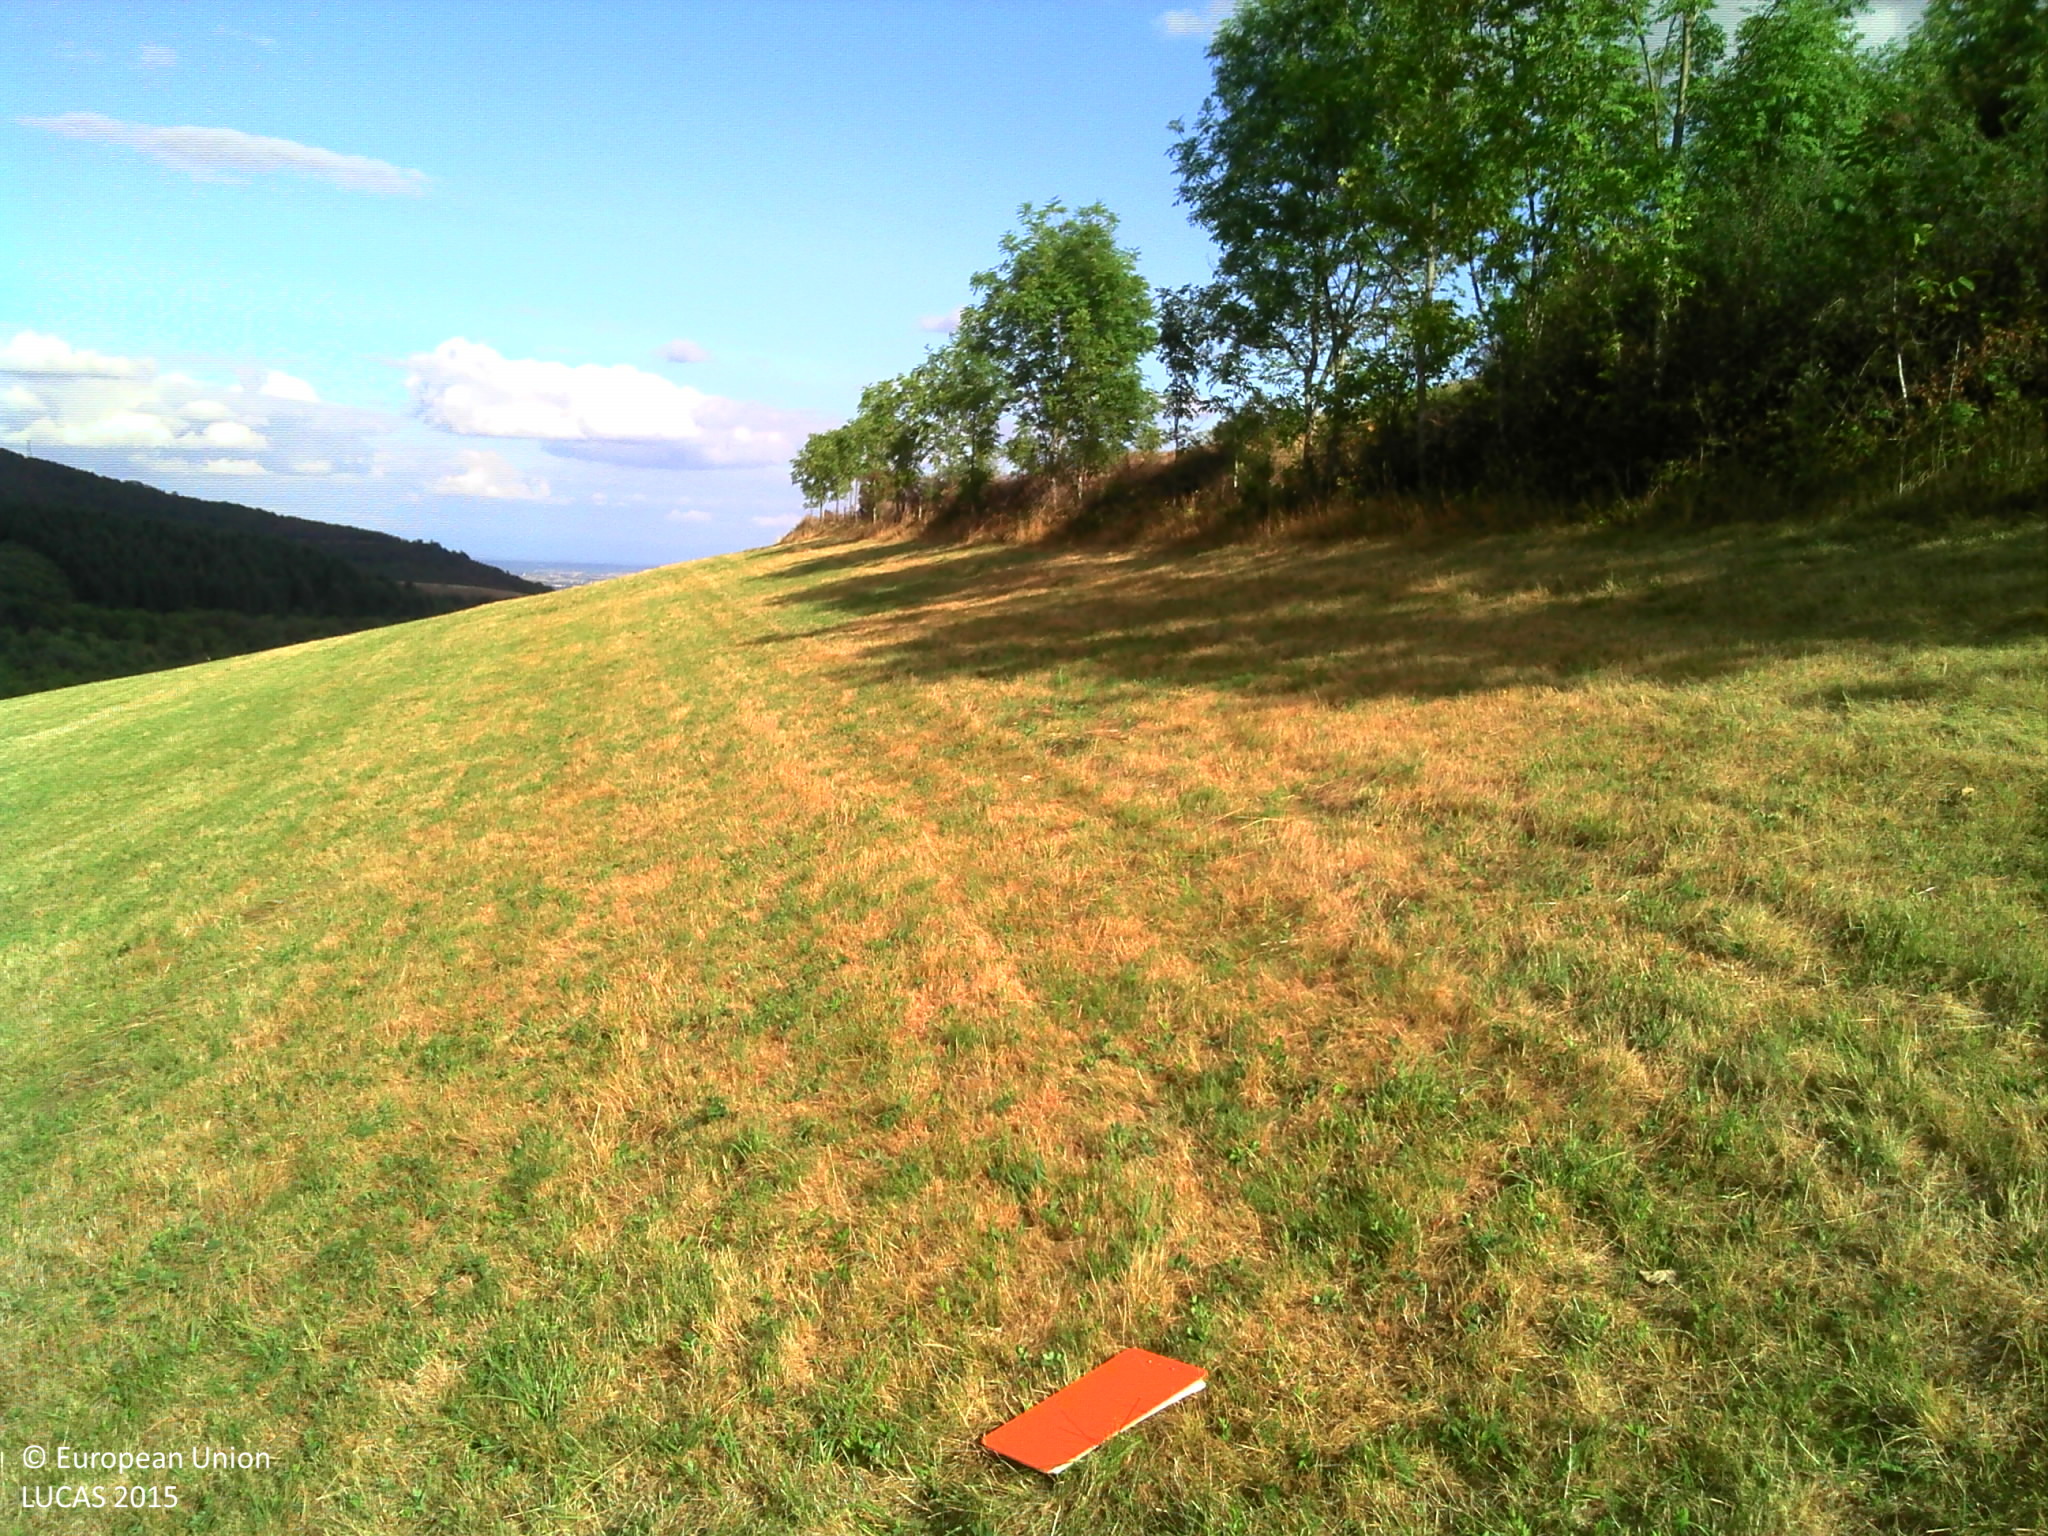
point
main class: Grassland
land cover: Grassland without tree/shrub cover
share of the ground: > 75 %
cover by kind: herbaceous plants 100 %
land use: Agriculture (excluding fallow land and kitchen gardens)
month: August
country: FR
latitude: 46.0145
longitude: 4.5650
